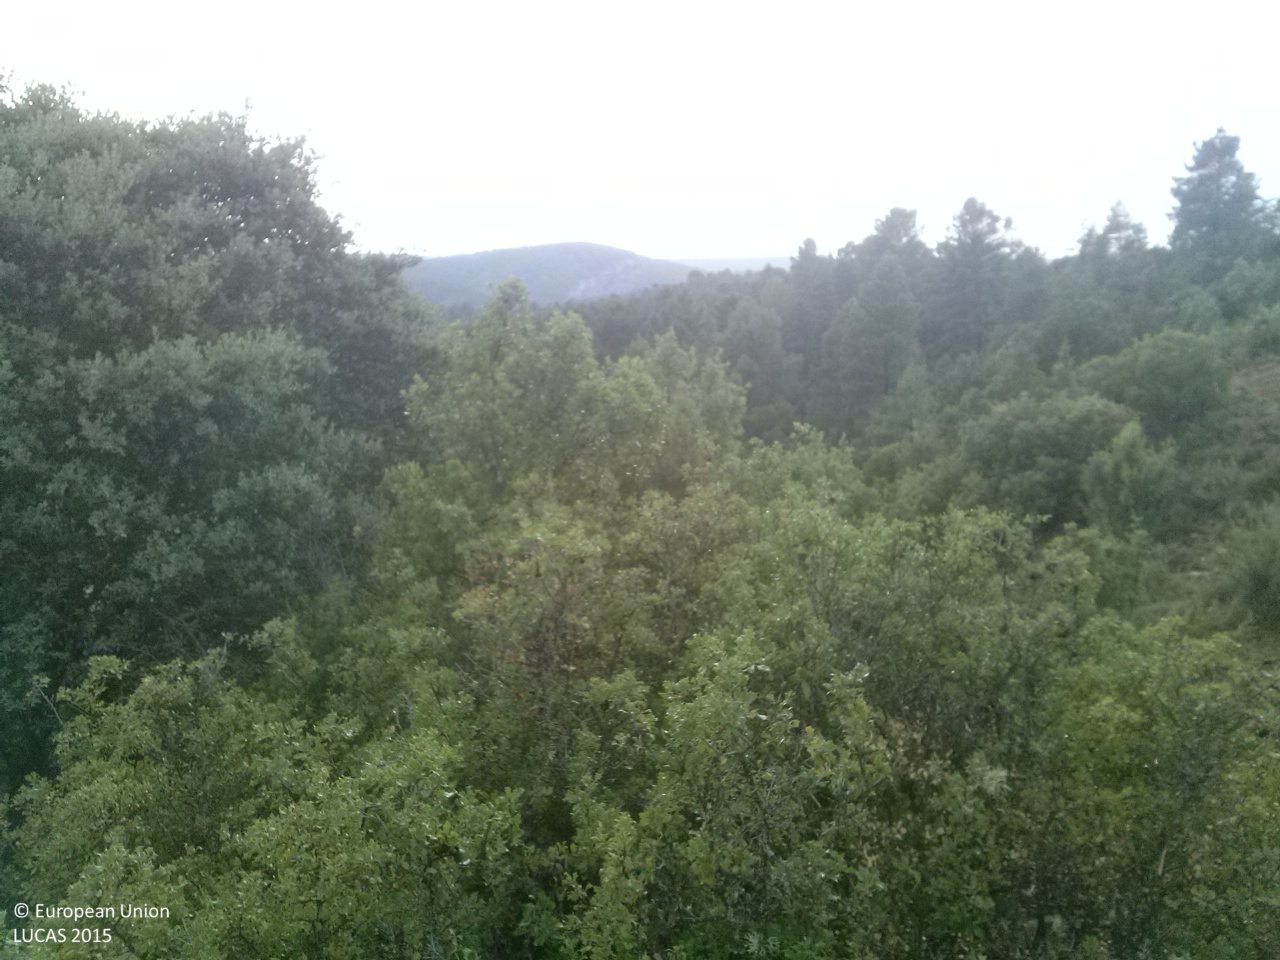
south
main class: Woodland
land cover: Other mixed woodland
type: broadleaved evergreen forest
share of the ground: 25 - 50 %
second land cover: Shrubland without tree cover
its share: 25 - 50 %
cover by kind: shrubs 35 %, broadleaved forest trees 25 %, unconsolidated bare surface 20 %, coniferous forest trees 10 %, herbaceous plants 10 %
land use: Forestry
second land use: Agriculture (excluding fallow land and kitchen gardens)
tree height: > 5 m
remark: Clear cut
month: June
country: ES
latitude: 39.8267
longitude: -1.7990
